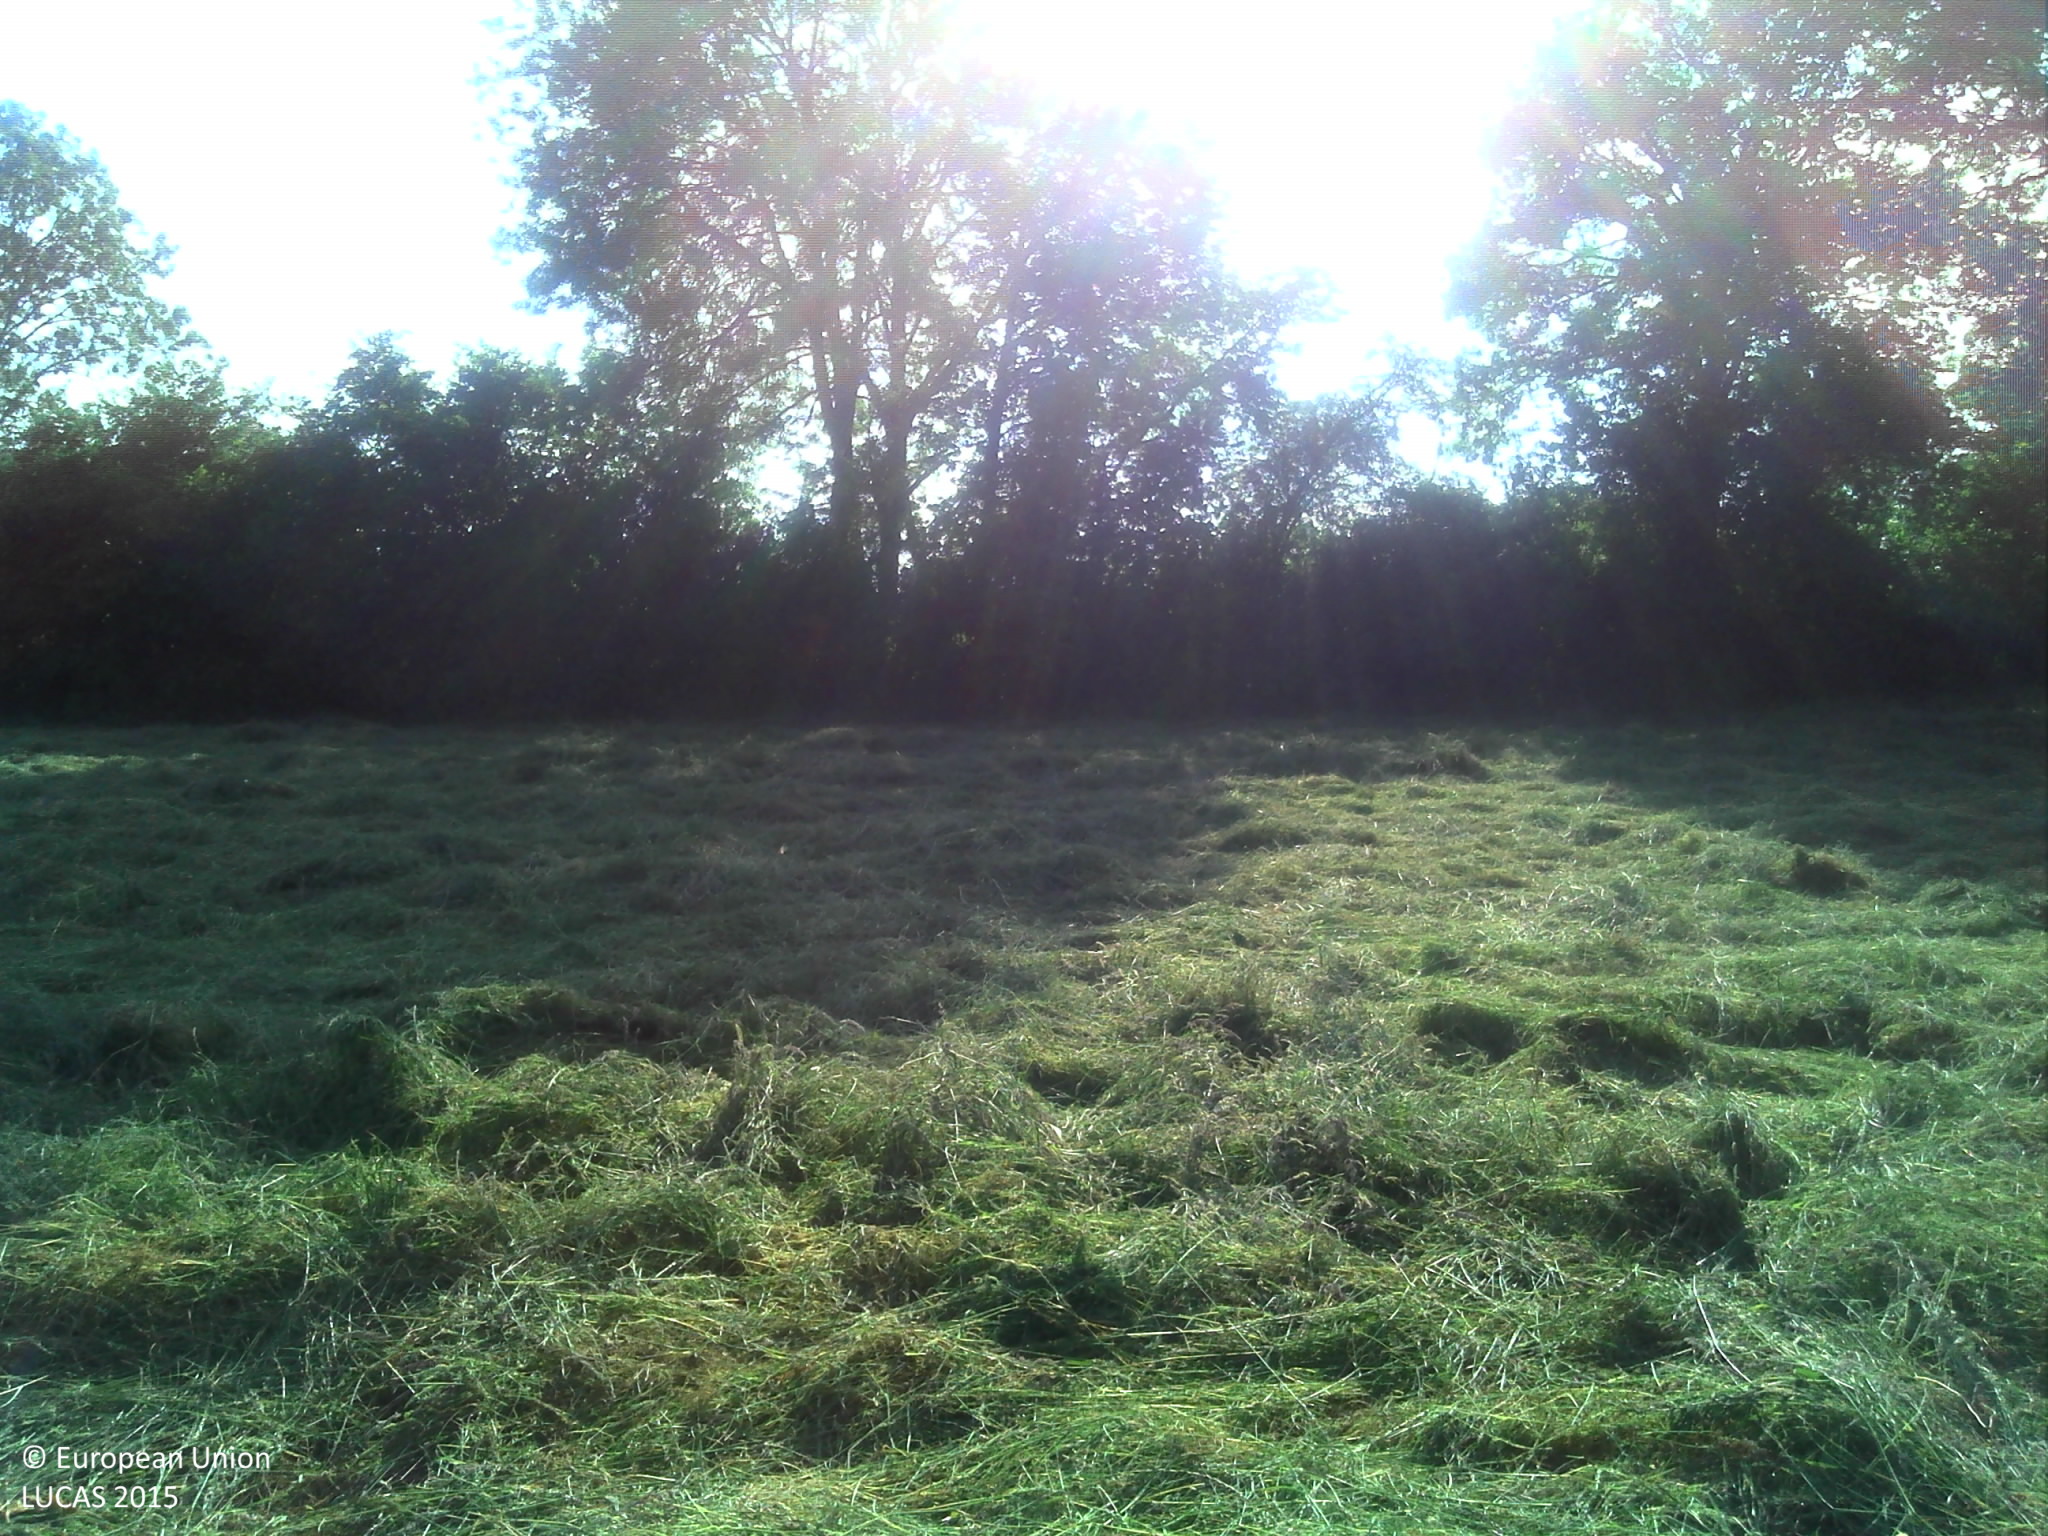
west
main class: Cropland
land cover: Mixed cereals for fodder
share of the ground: > 75 %
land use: Agriculture (excluding fallow land and kitchen gardens)
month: May
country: FR
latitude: 48.6609
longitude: -0.1461
